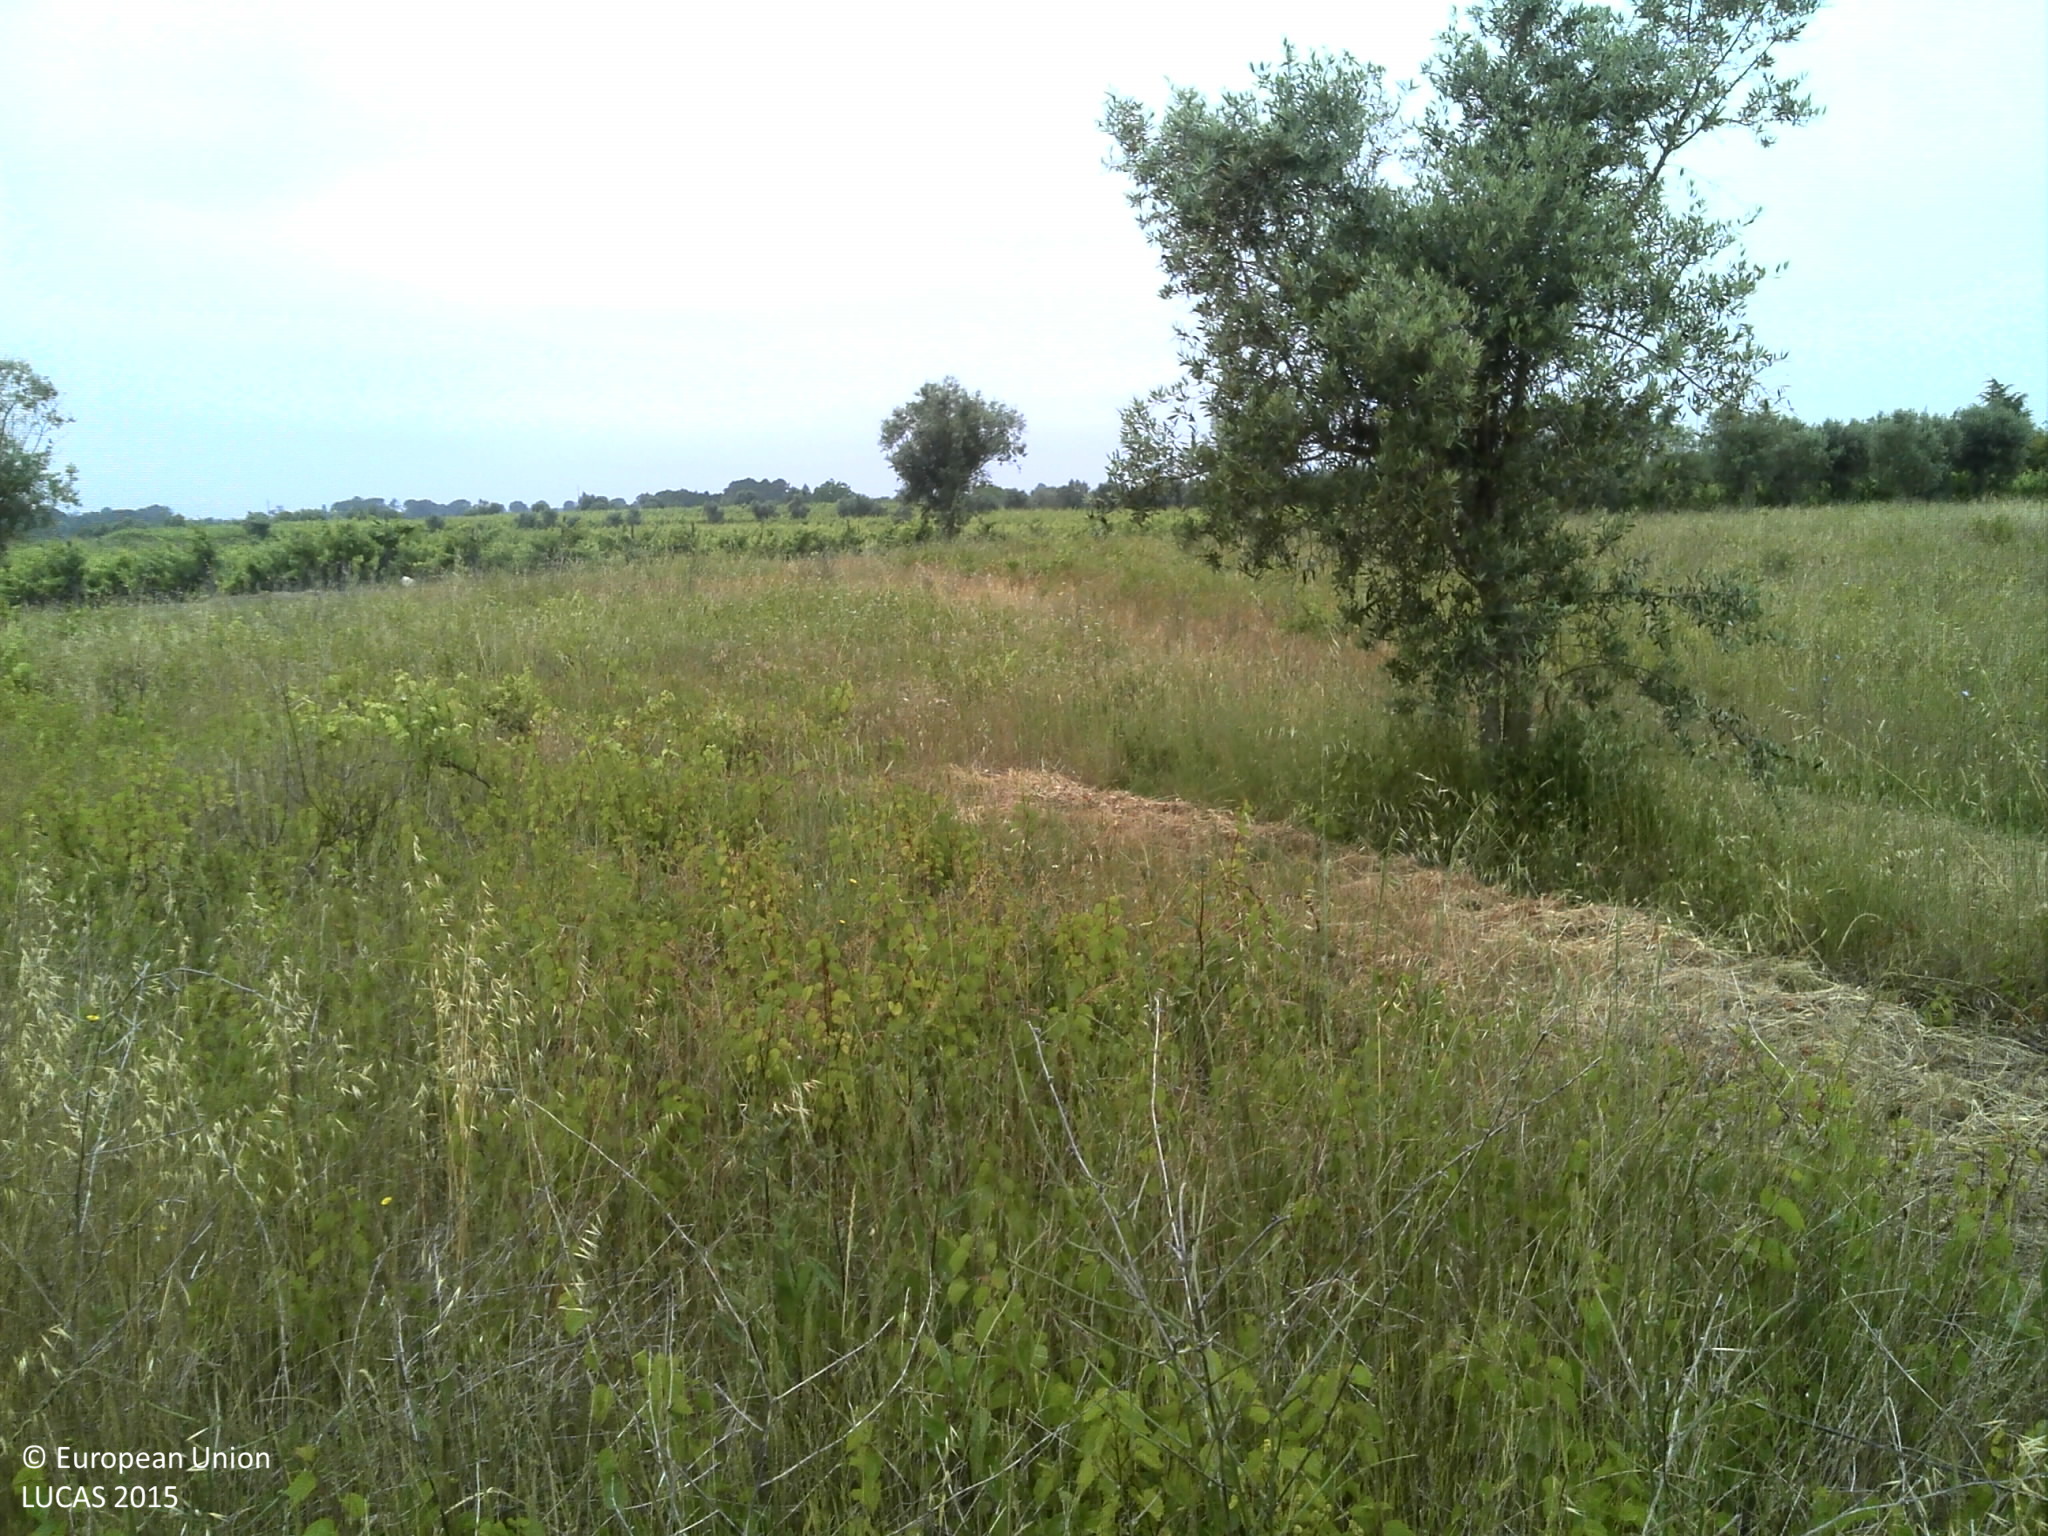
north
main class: Cropland
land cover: Vineyards
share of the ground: 10 - 25 %
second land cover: Grassland without tree/shrub cover
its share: 50 - 75 %
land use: Abandoned areas
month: June
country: PT
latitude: 40.3208
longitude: -8.6024
